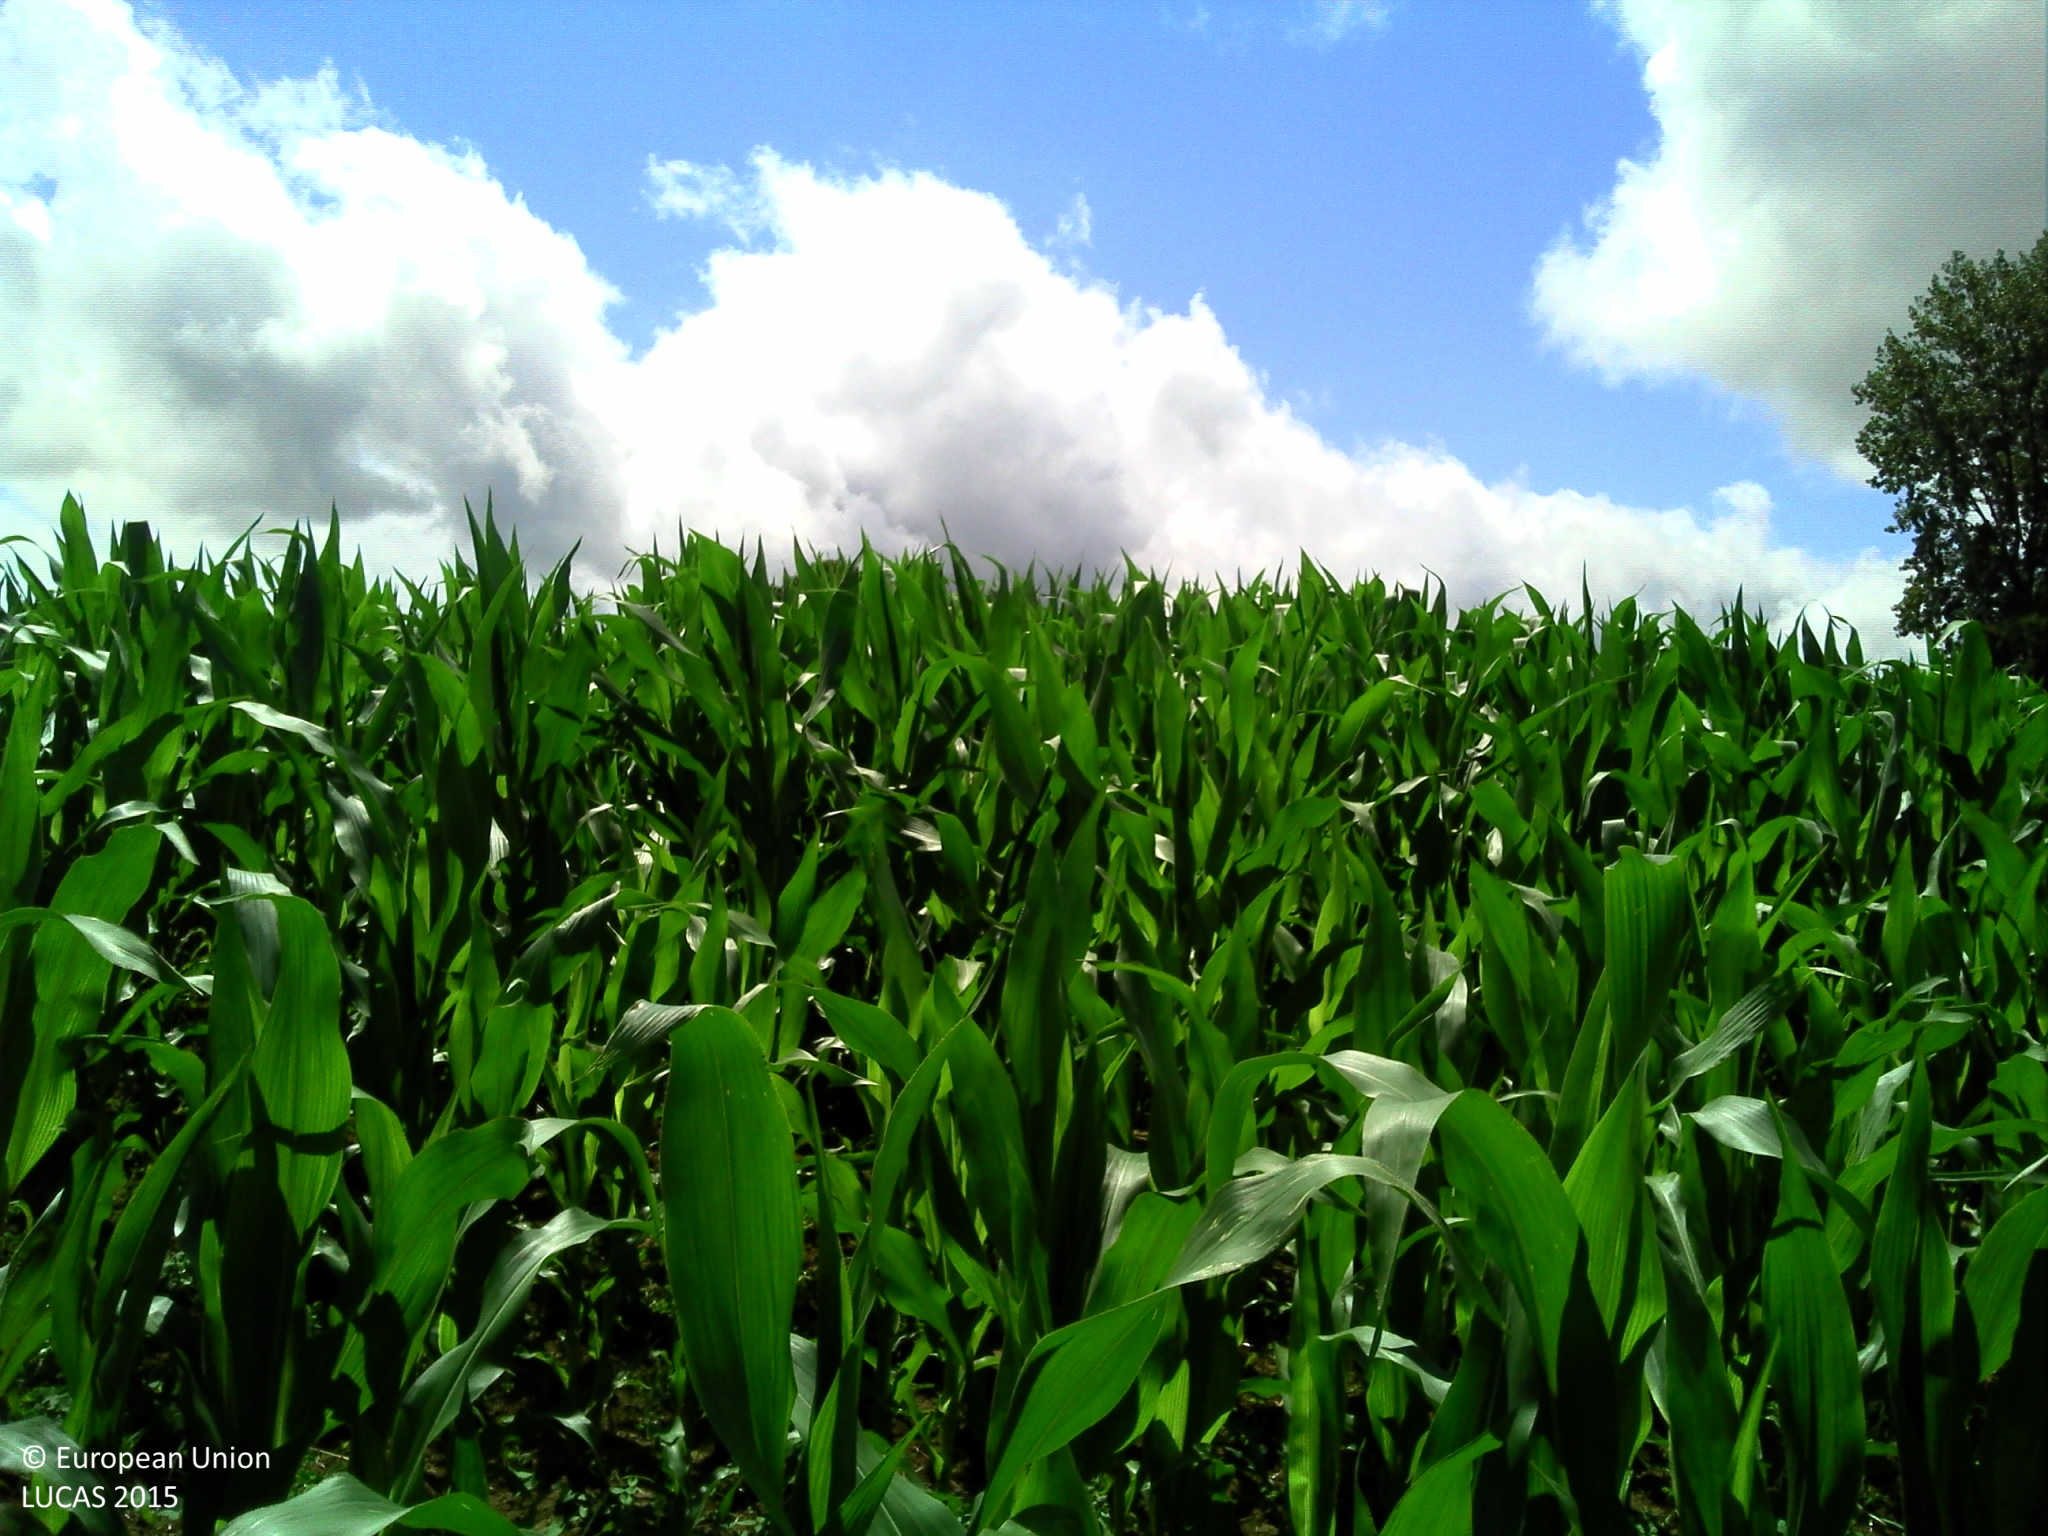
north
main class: Cropland
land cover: Maize
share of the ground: > 75 %
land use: Agriculture (excluding fallow land and kitchen gardens)
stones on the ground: < 10 %
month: July
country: FR
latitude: 48.2741
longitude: -2.3330
